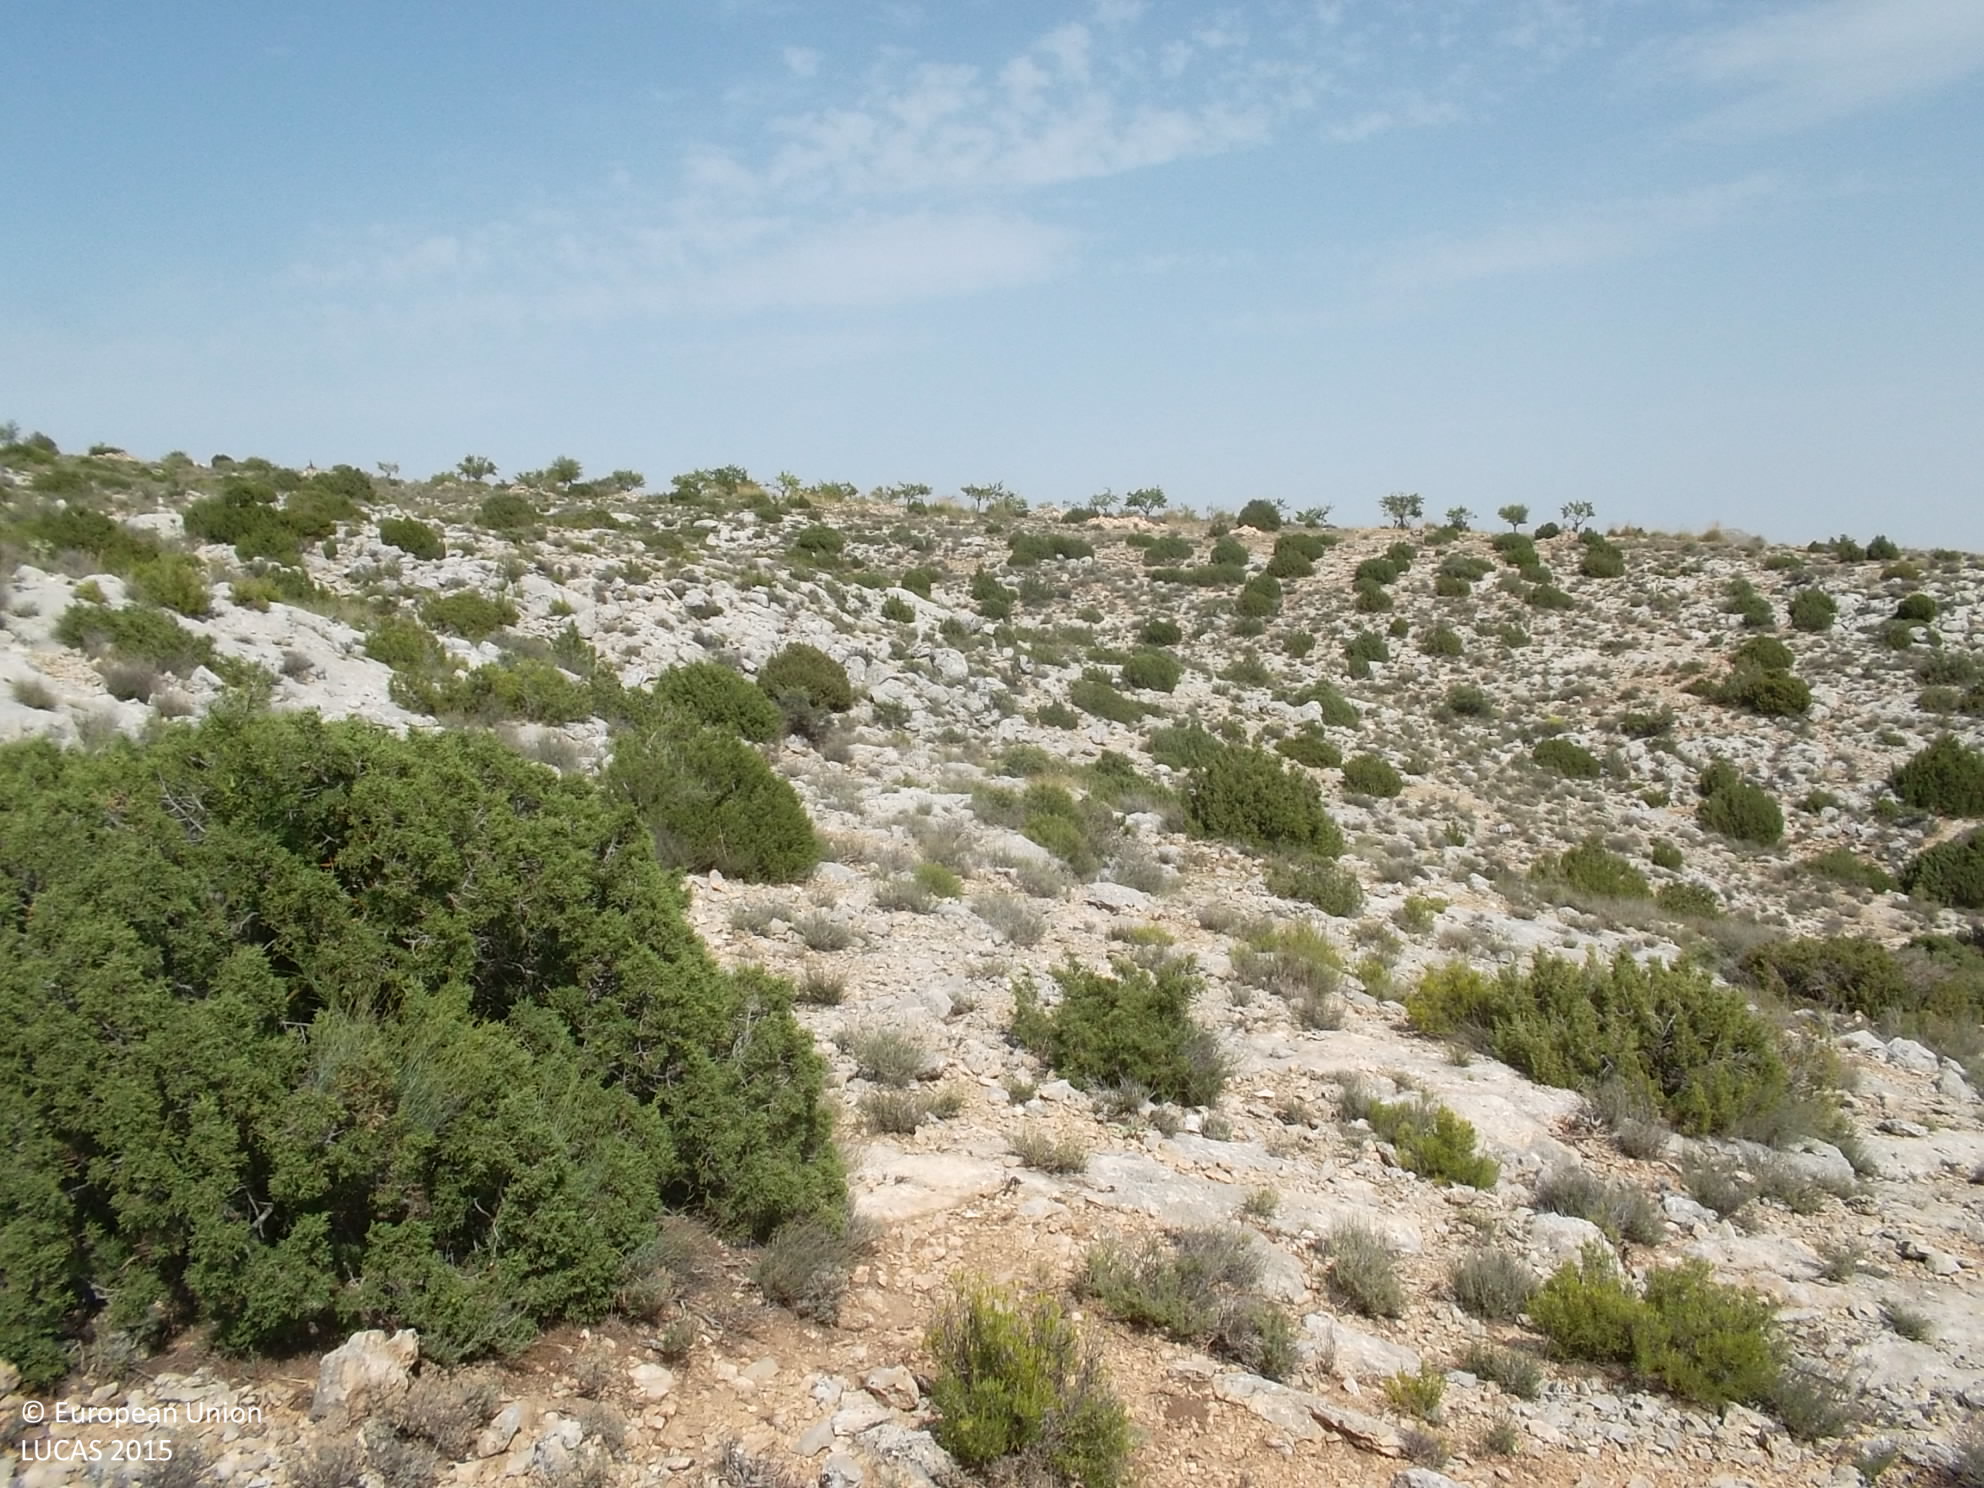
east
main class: Shrubland
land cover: Shrubland without tree cover
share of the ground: 50 - 75 %
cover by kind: shrubs 50 %, consolidated bare surface 30 %, herbaceous plants 20 %
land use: Semi-natural and natural areas not in use
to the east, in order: Shrubland without tree cover; Rock outcrops; Shrubland without tree cover; Nuts trees
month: July
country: ES
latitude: 37.9188
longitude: -2.4239
